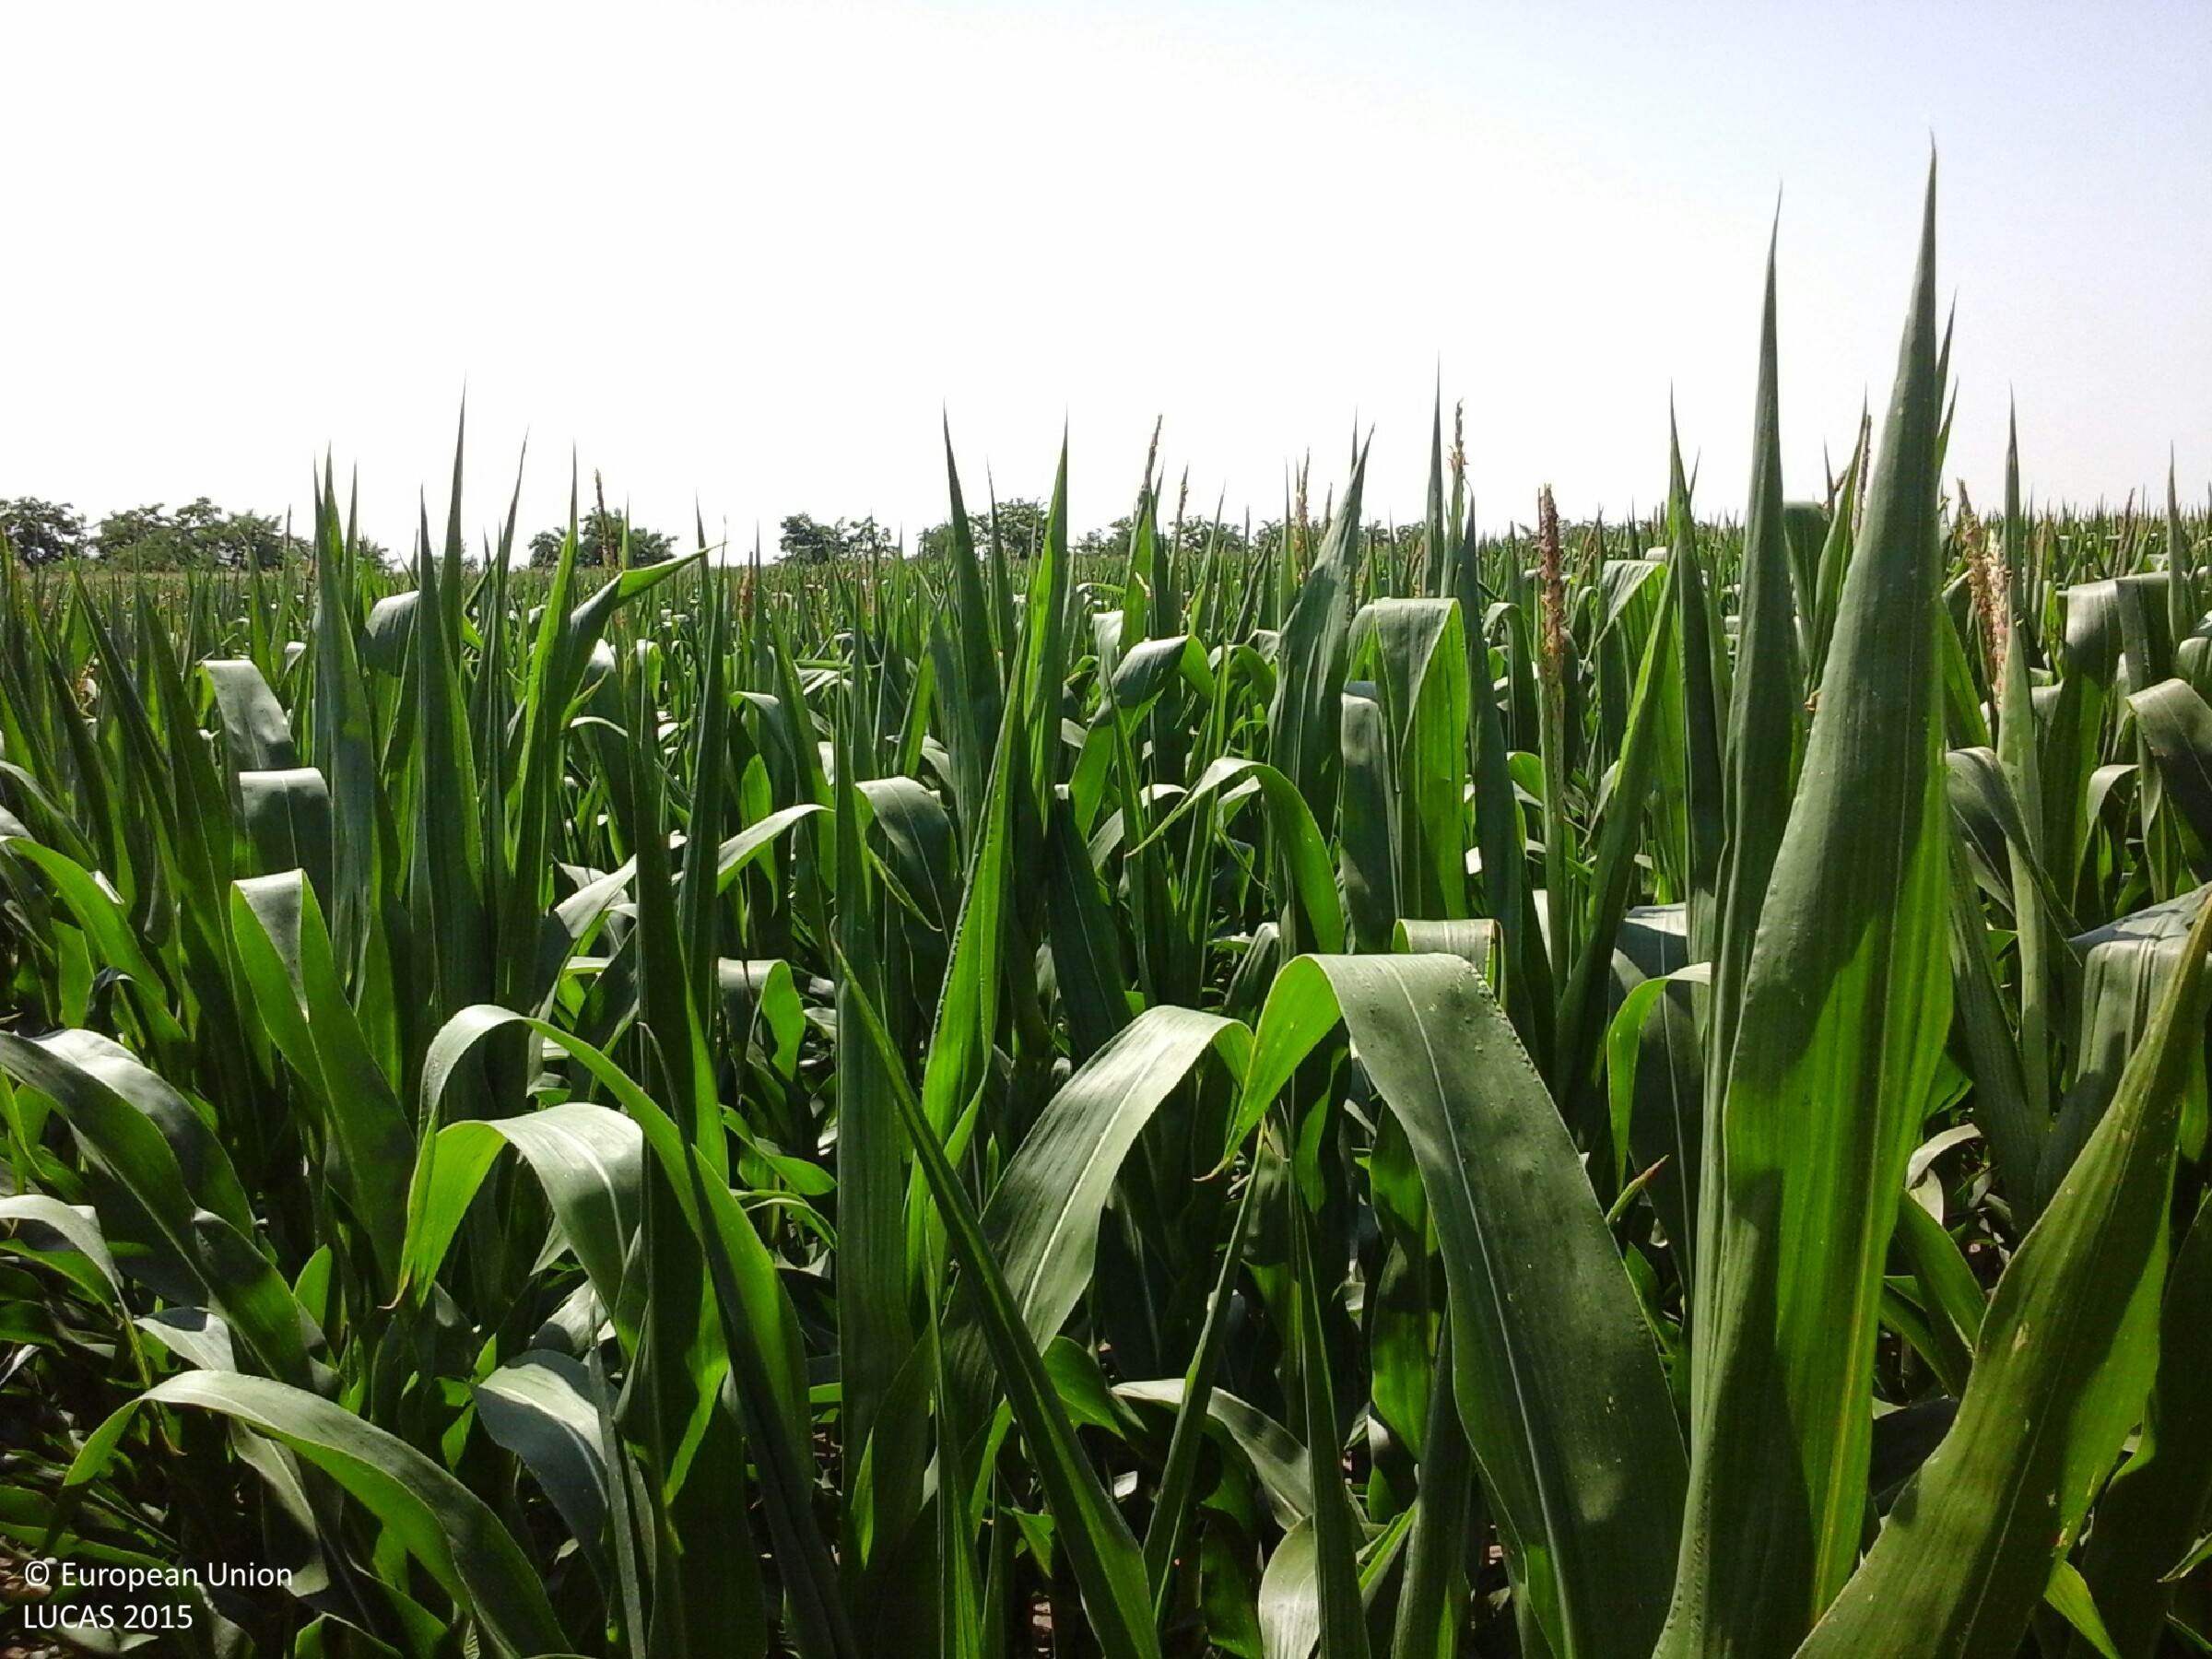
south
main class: Cropland
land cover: Maize
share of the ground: > 75 %
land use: Agriculture (excluding fallow land and kitchen gardens)
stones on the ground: < 10 %
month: July
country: HU
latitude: 48.0988
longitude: 20.9015
